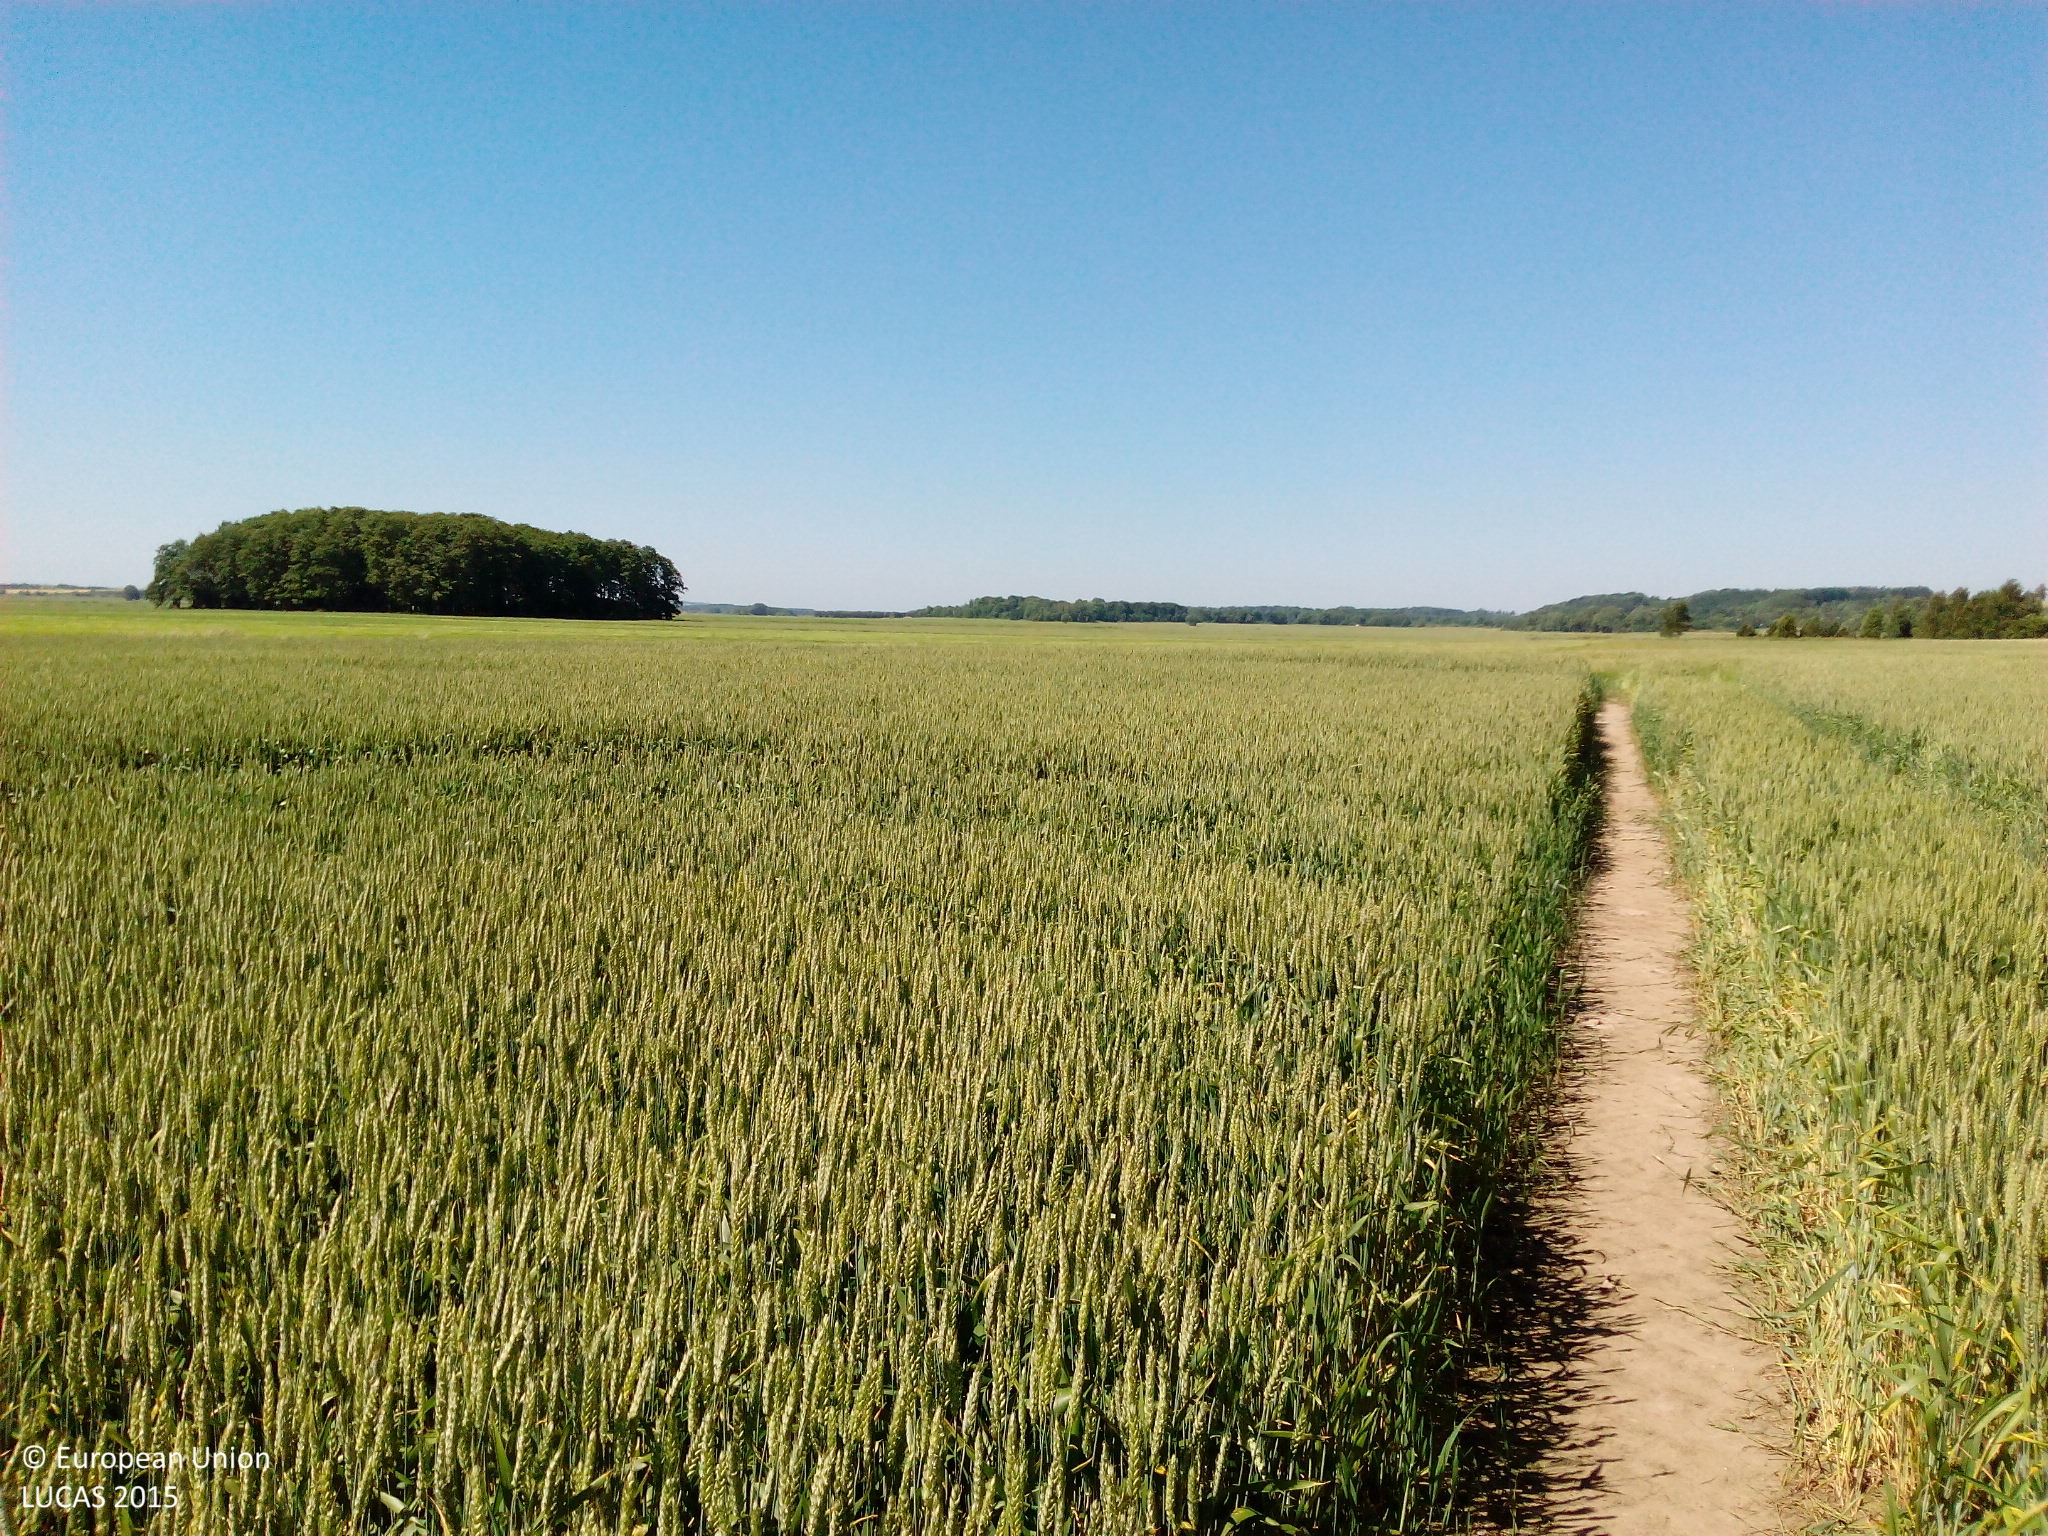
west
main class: Cropland
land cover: Common wheat
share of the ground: > 75 %
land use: Agriculture (excluding fallow land and kitchen gardens)
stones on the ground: 10 - 25 %
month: July
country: DK
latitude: 56.3838
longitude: 10.6632
